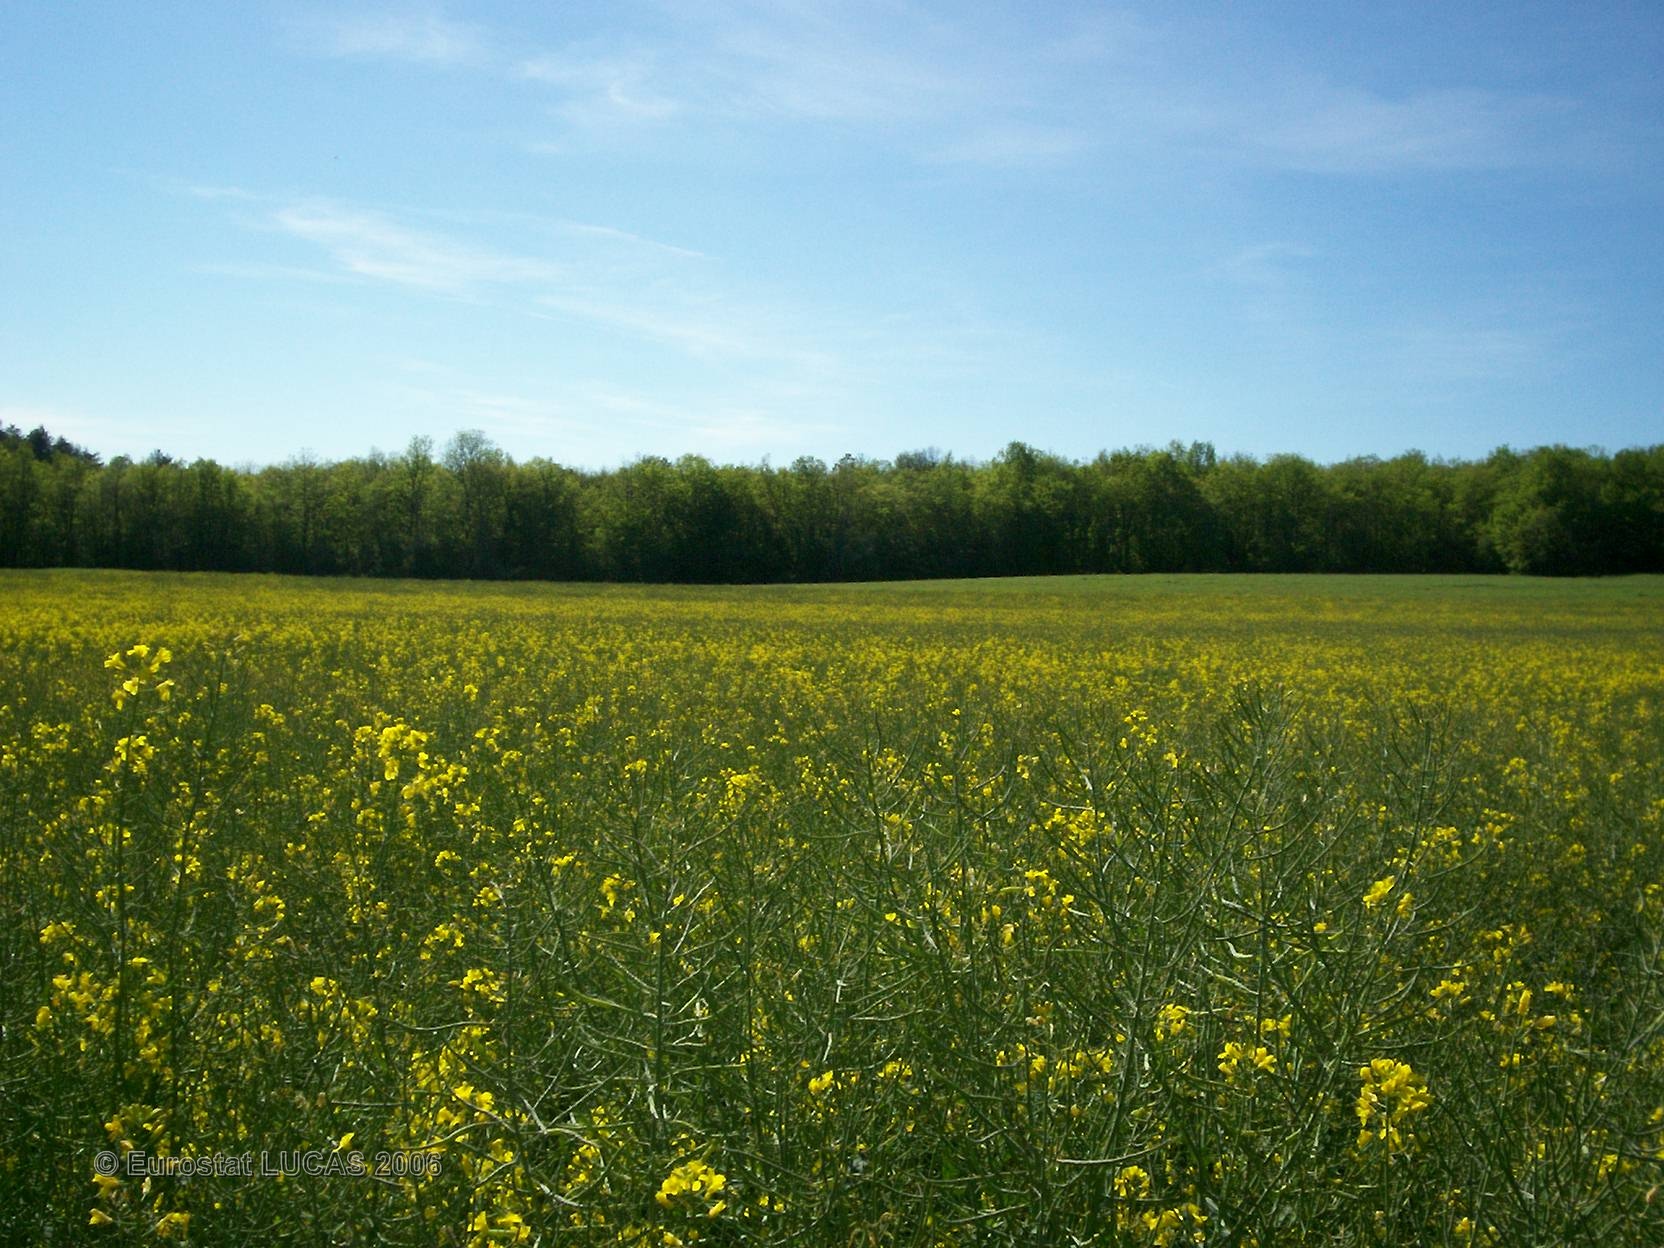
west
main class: Cropland
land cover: Rape and turnip rape
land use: Agriculture (excluding fallow land and kitchen gardens)
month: May
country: FR
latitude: 45.2697
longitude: 0.8519
